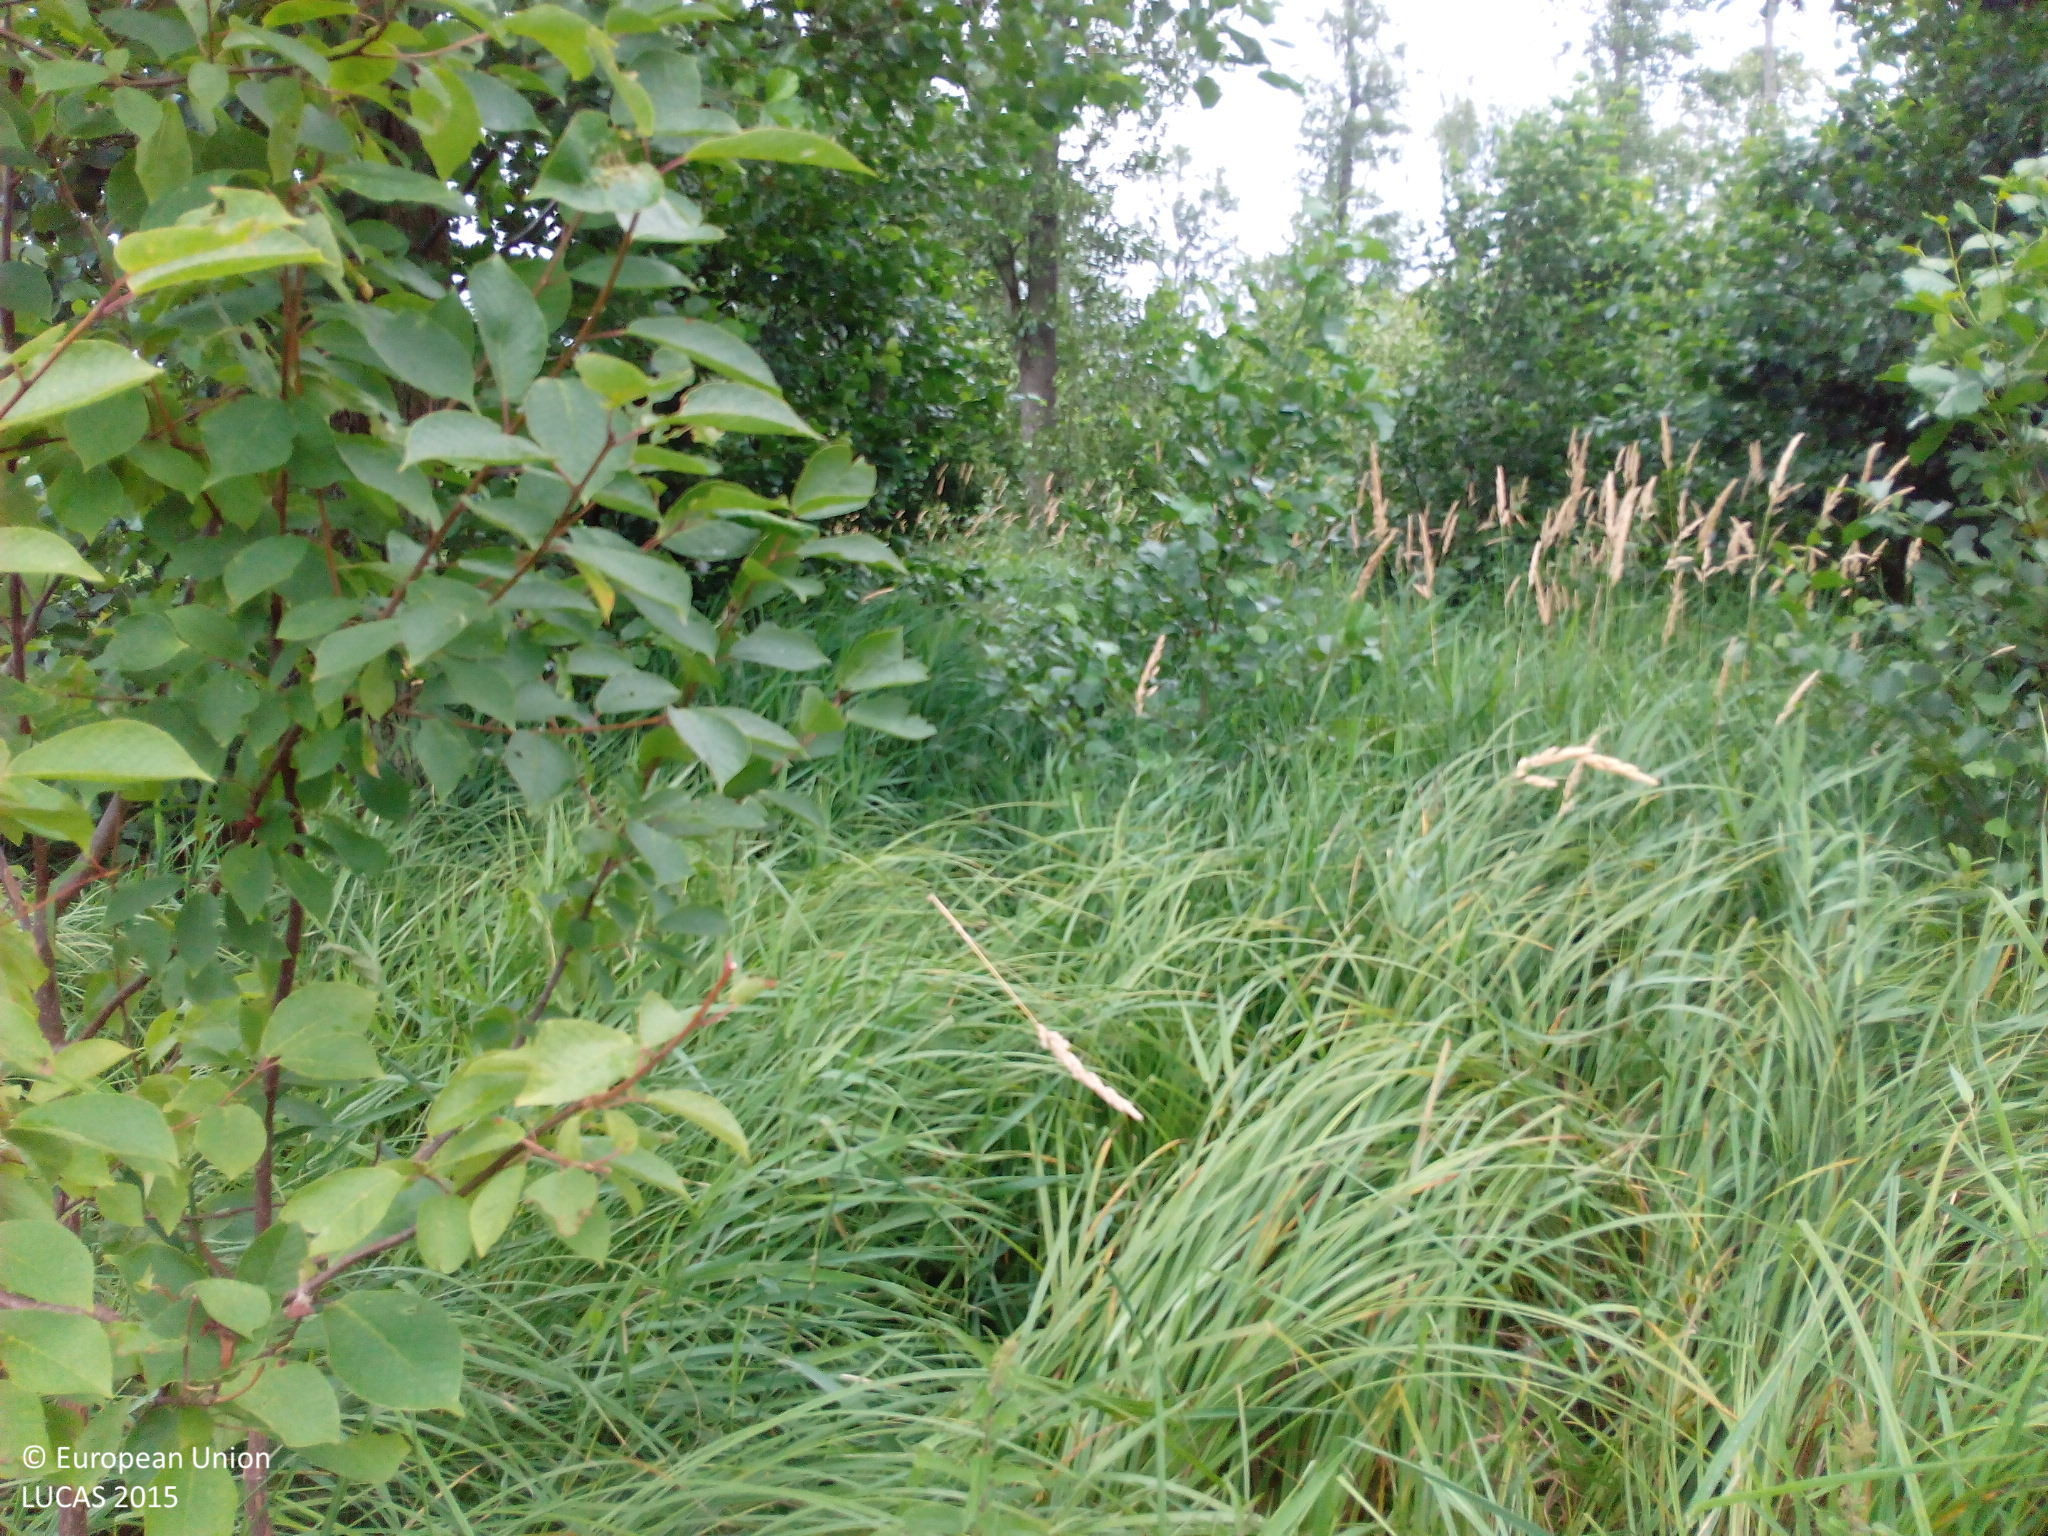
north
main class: Woodland
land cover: Broadleaved woodland
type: mesophytic deciduous forest
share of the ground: 50 - 75 %
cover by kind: broadleaved forest trees 60 %, herbaceous plants 40 %
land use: Forestry
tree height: > 5 m
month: July
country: DE
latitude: 54.2527
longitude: 12.7157
